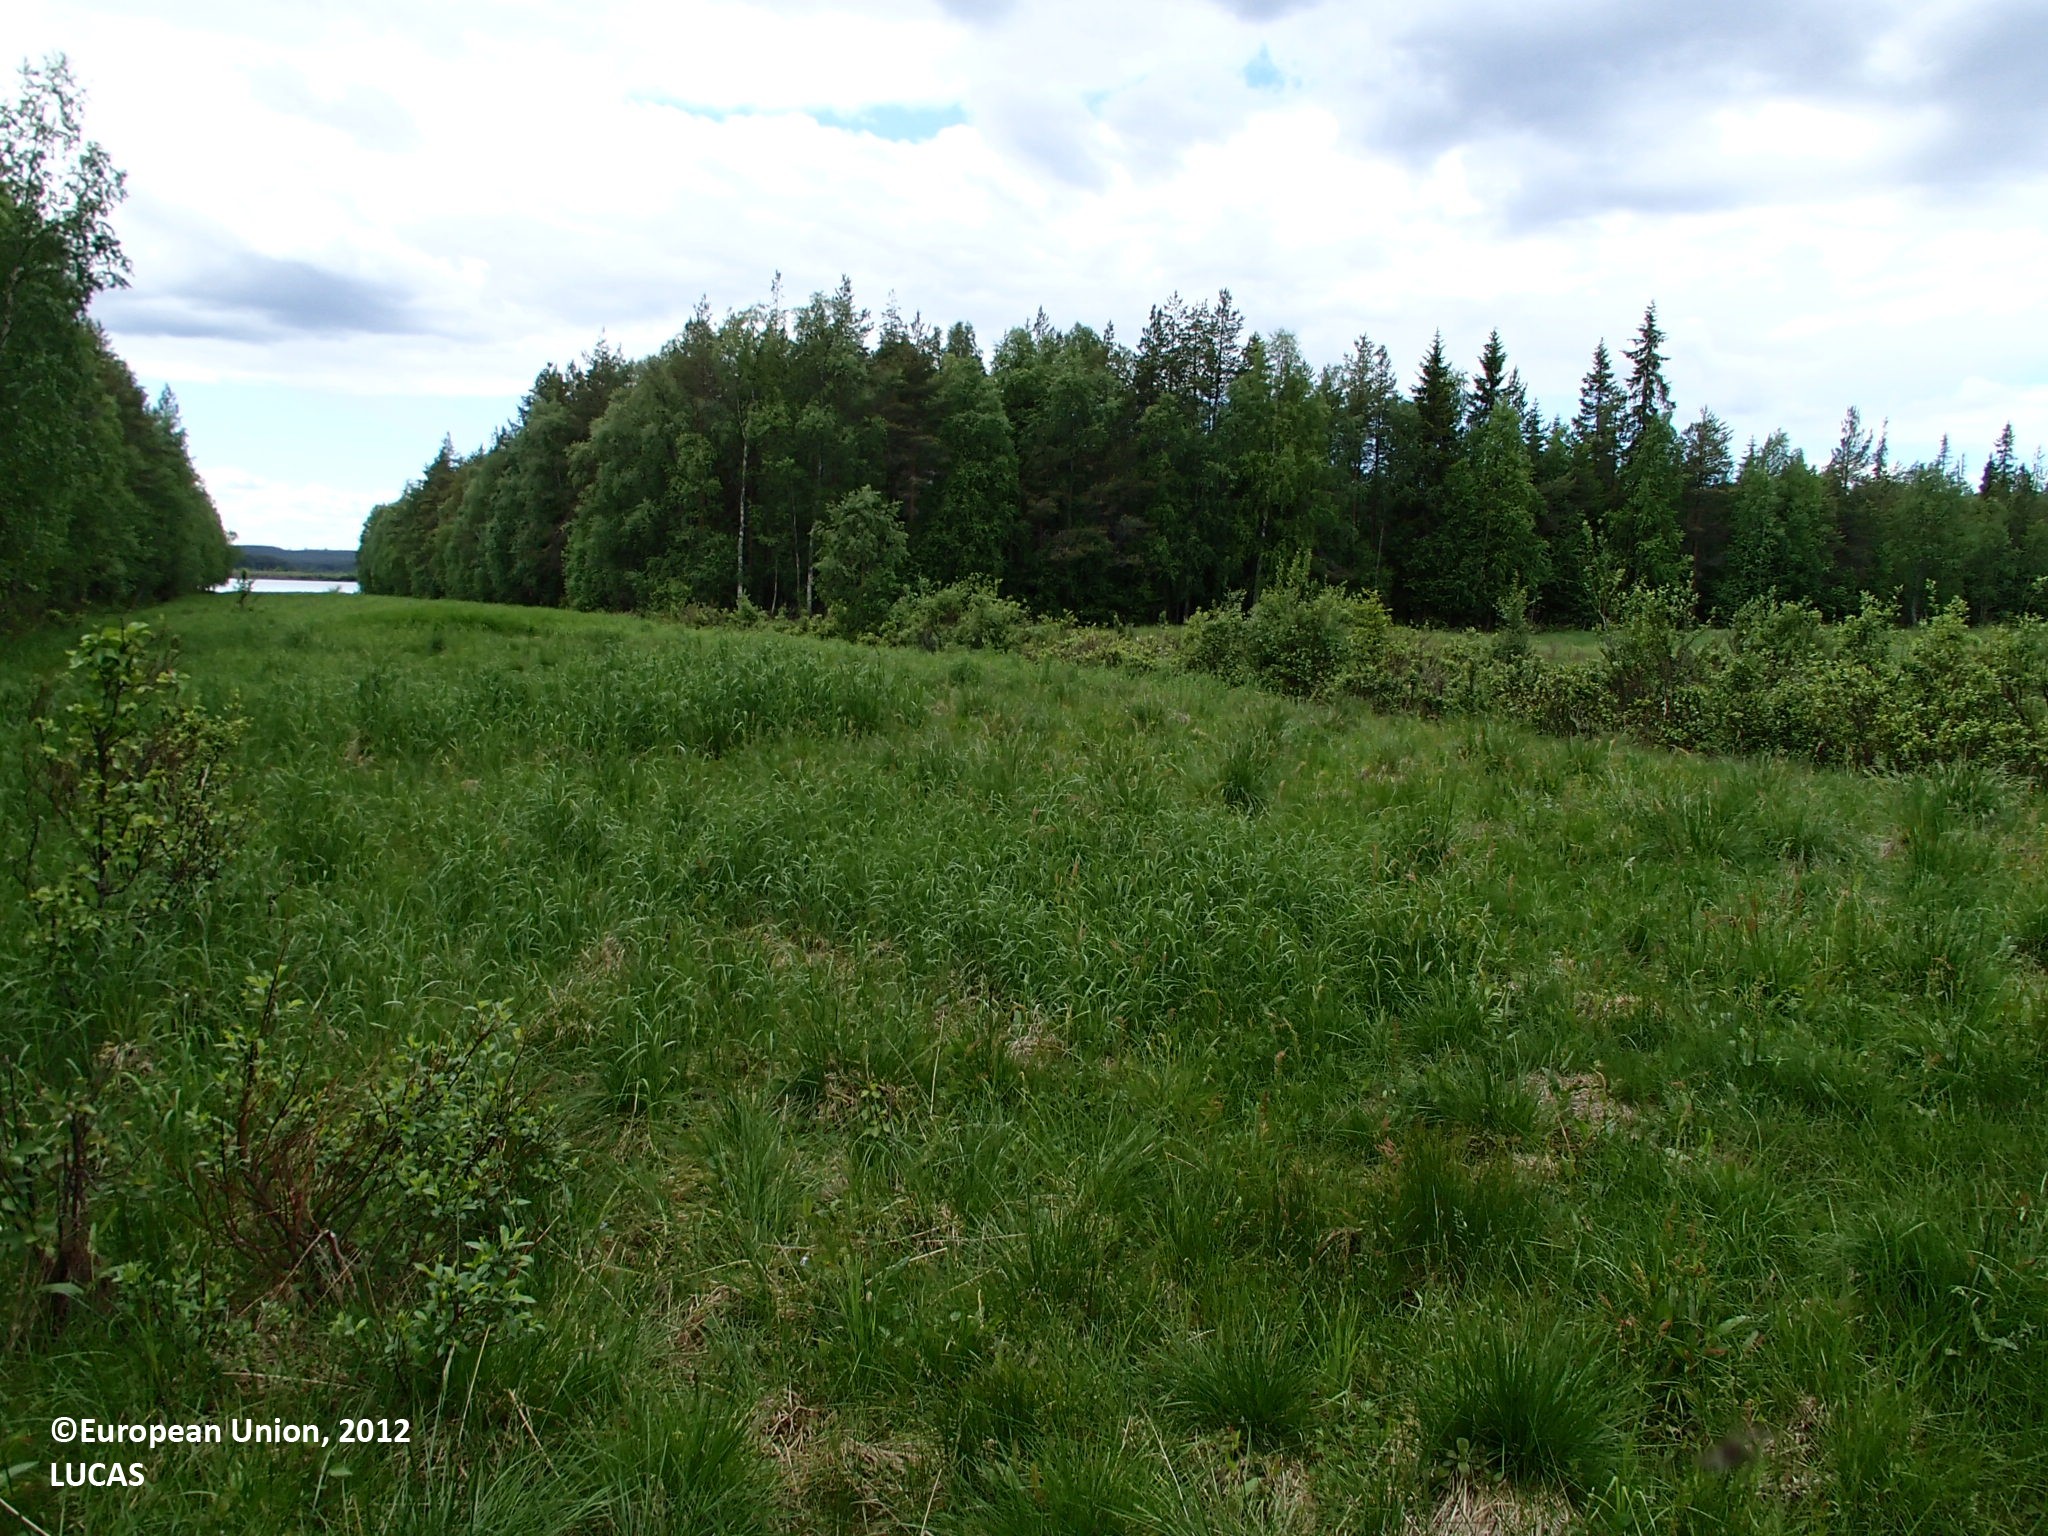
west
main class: Grassland
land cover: Grassland with sparse tree/shrub cover
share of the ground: > 75 %
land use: Abandoned areas
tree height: < 5 m
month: June
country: FI
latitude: 66.5303
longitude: 27.2758
